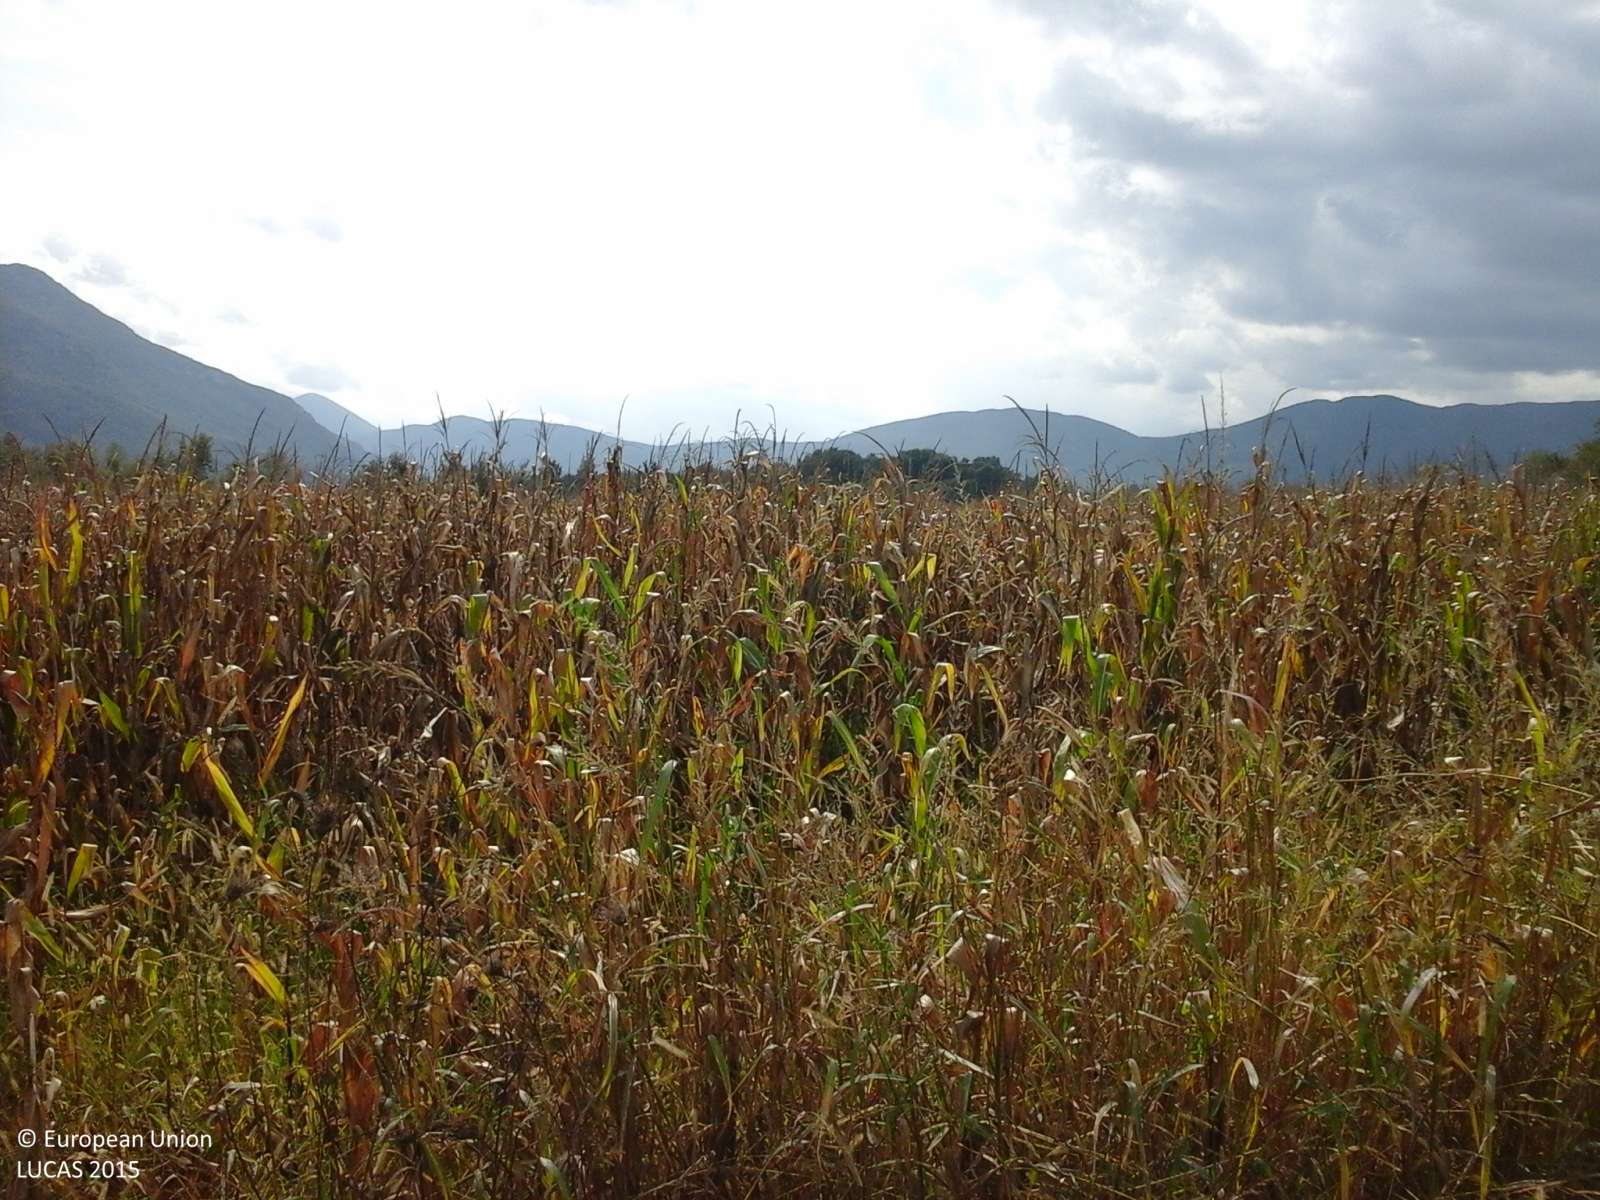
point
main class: Cropland
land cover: Maize
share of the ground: > 75 %
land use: Agriculture (excluding fallow land and kitchen gardens)
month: October
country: GR
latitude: 40.0291
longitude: 20.6800
